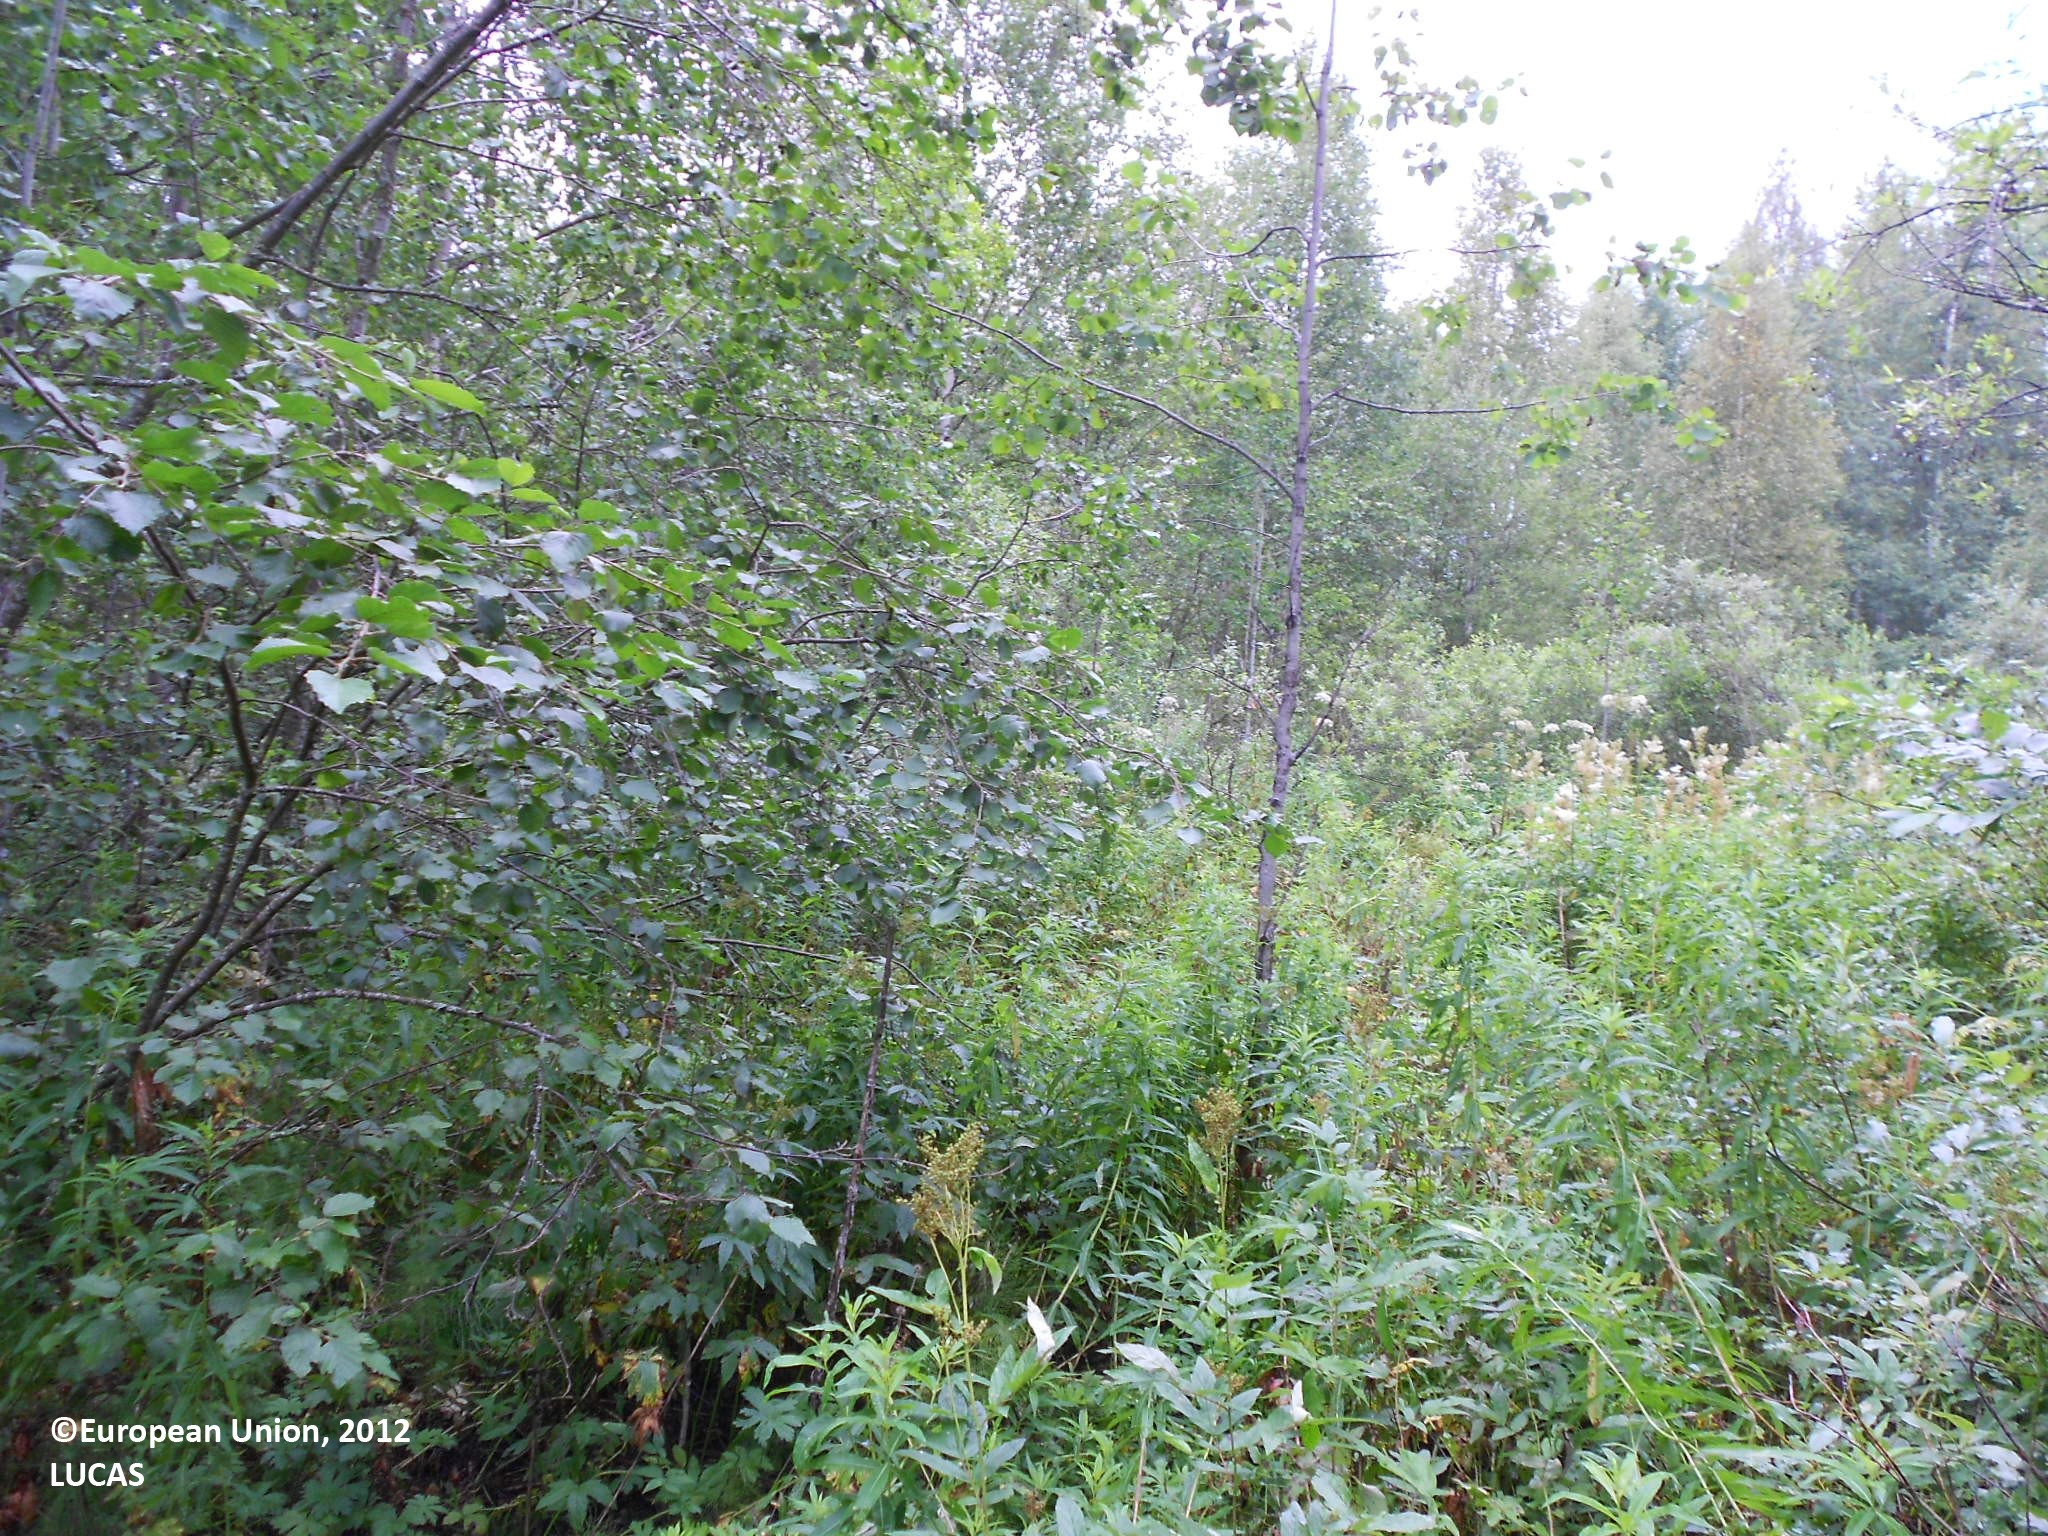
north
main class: Woodland
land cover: Broadleaved woodland
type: boreal forest
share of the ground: 50 - 75 %
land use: Forestry
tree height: > 5 m
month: August
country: FI
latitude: 63.5050
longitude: 28.9092
